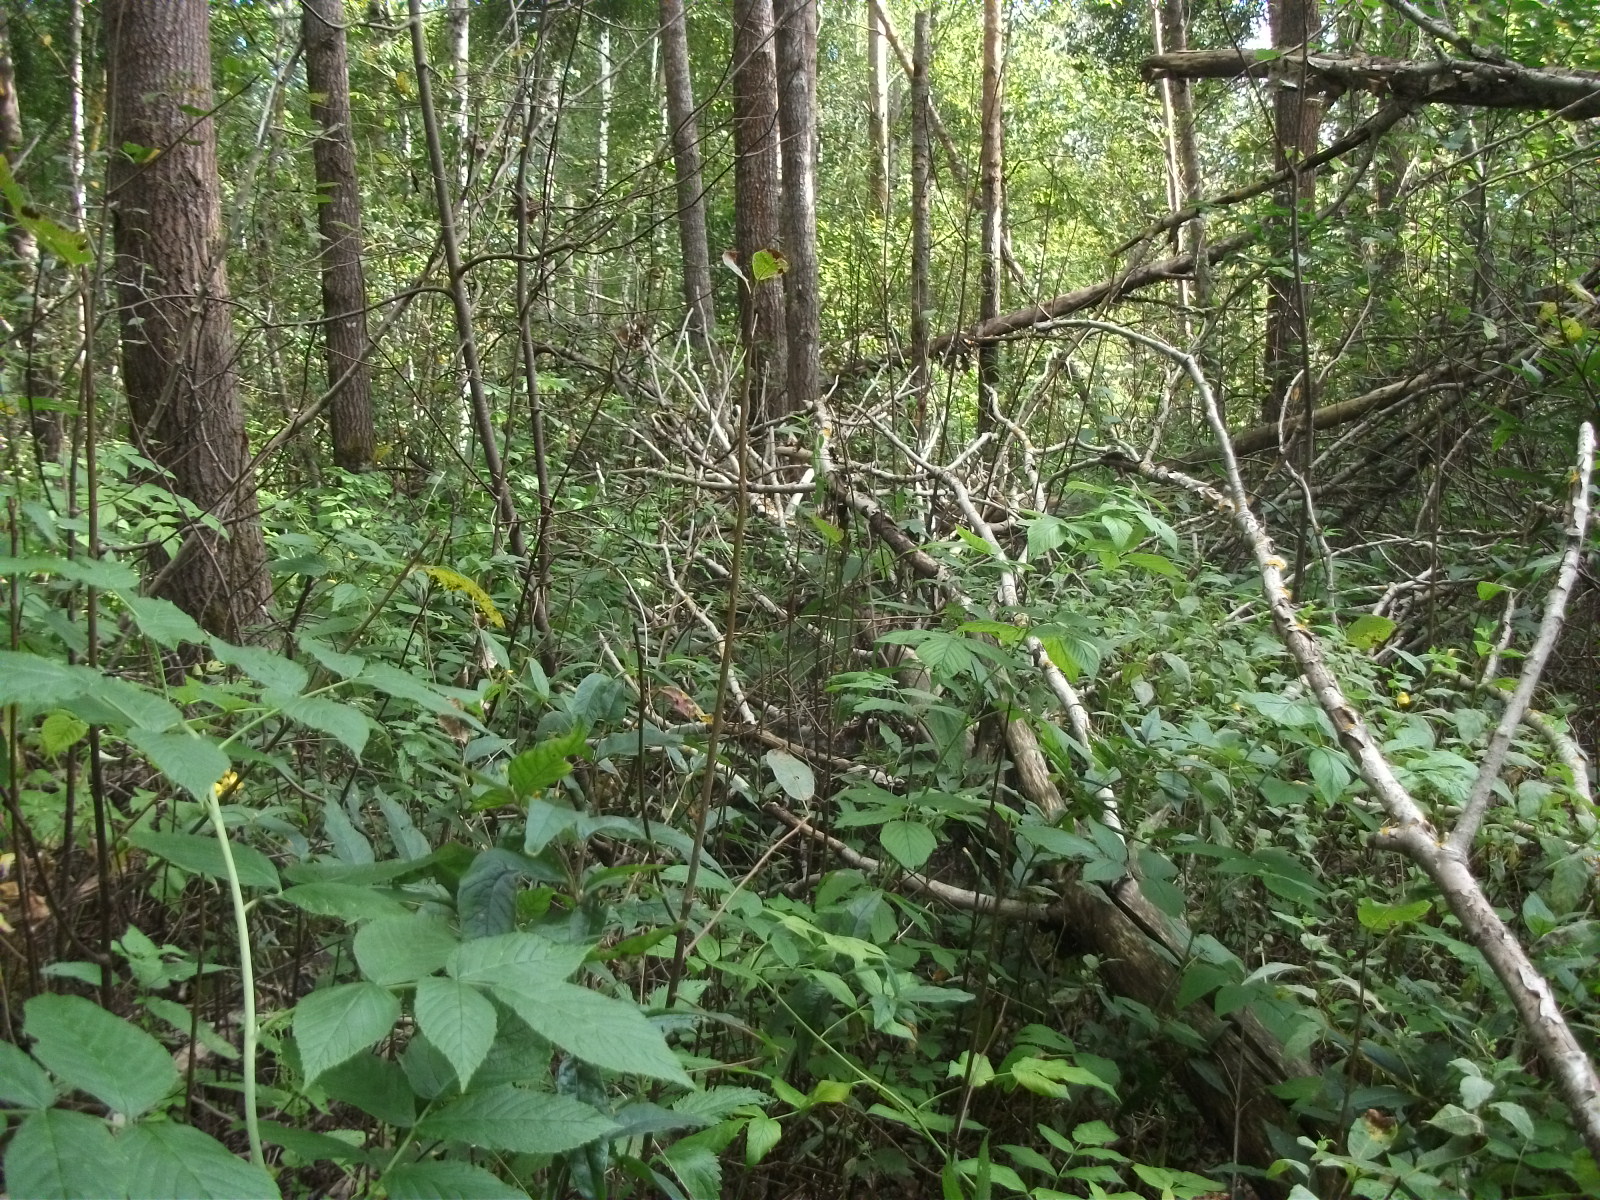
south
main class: Woodland
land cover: Broadleaved woodland
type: non-riverine alder, birch or aspen forest
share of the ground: > 75 %
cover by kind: broadleaved forest trees 80 %, shrubs 10 %, herbaceous plants 10 %
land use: Forestry
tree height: > 5 m
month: August
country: LV
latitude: 56.3961
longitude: 26.3615
